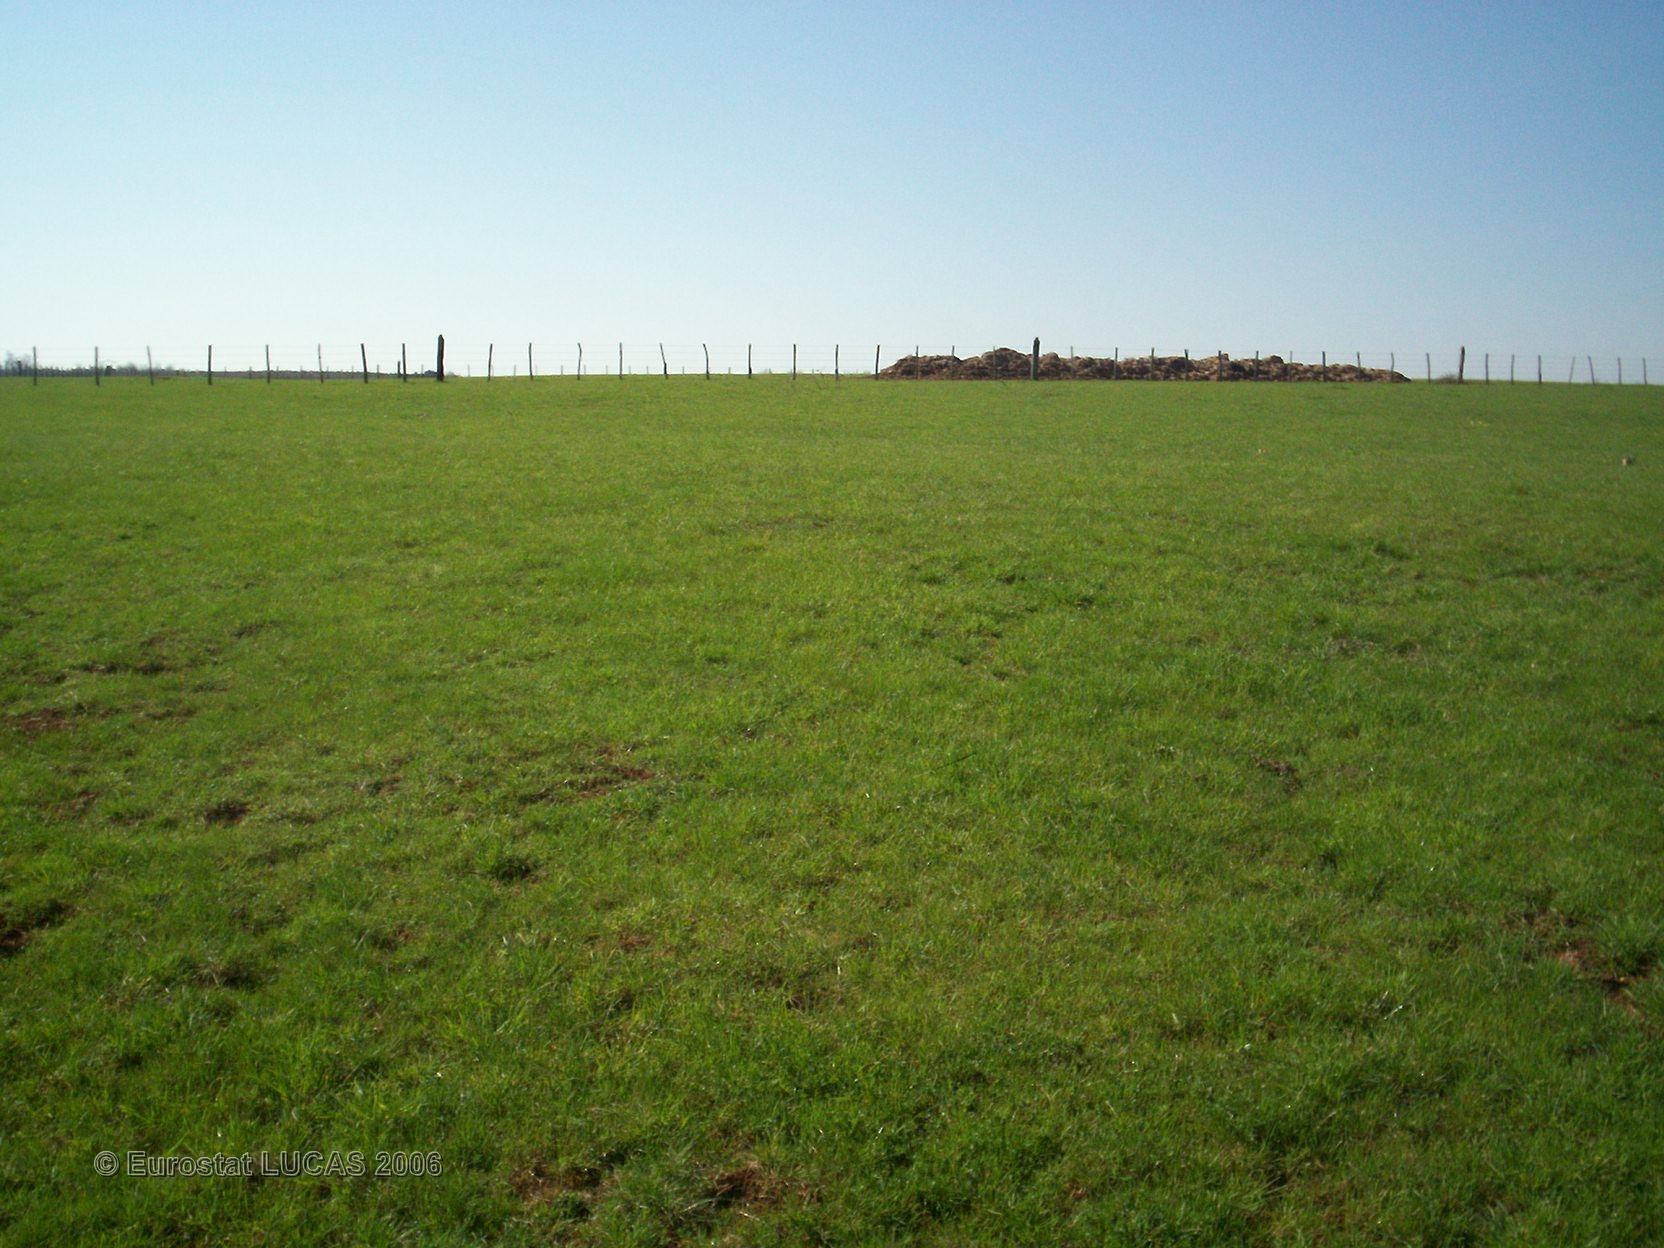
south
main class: Grassland
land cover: Grassland without tree/shrub cover
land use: Agriculture (excluding fallow land and kitchen gardens)
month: April
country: FR
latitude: 47.3869
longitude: 4.5815
